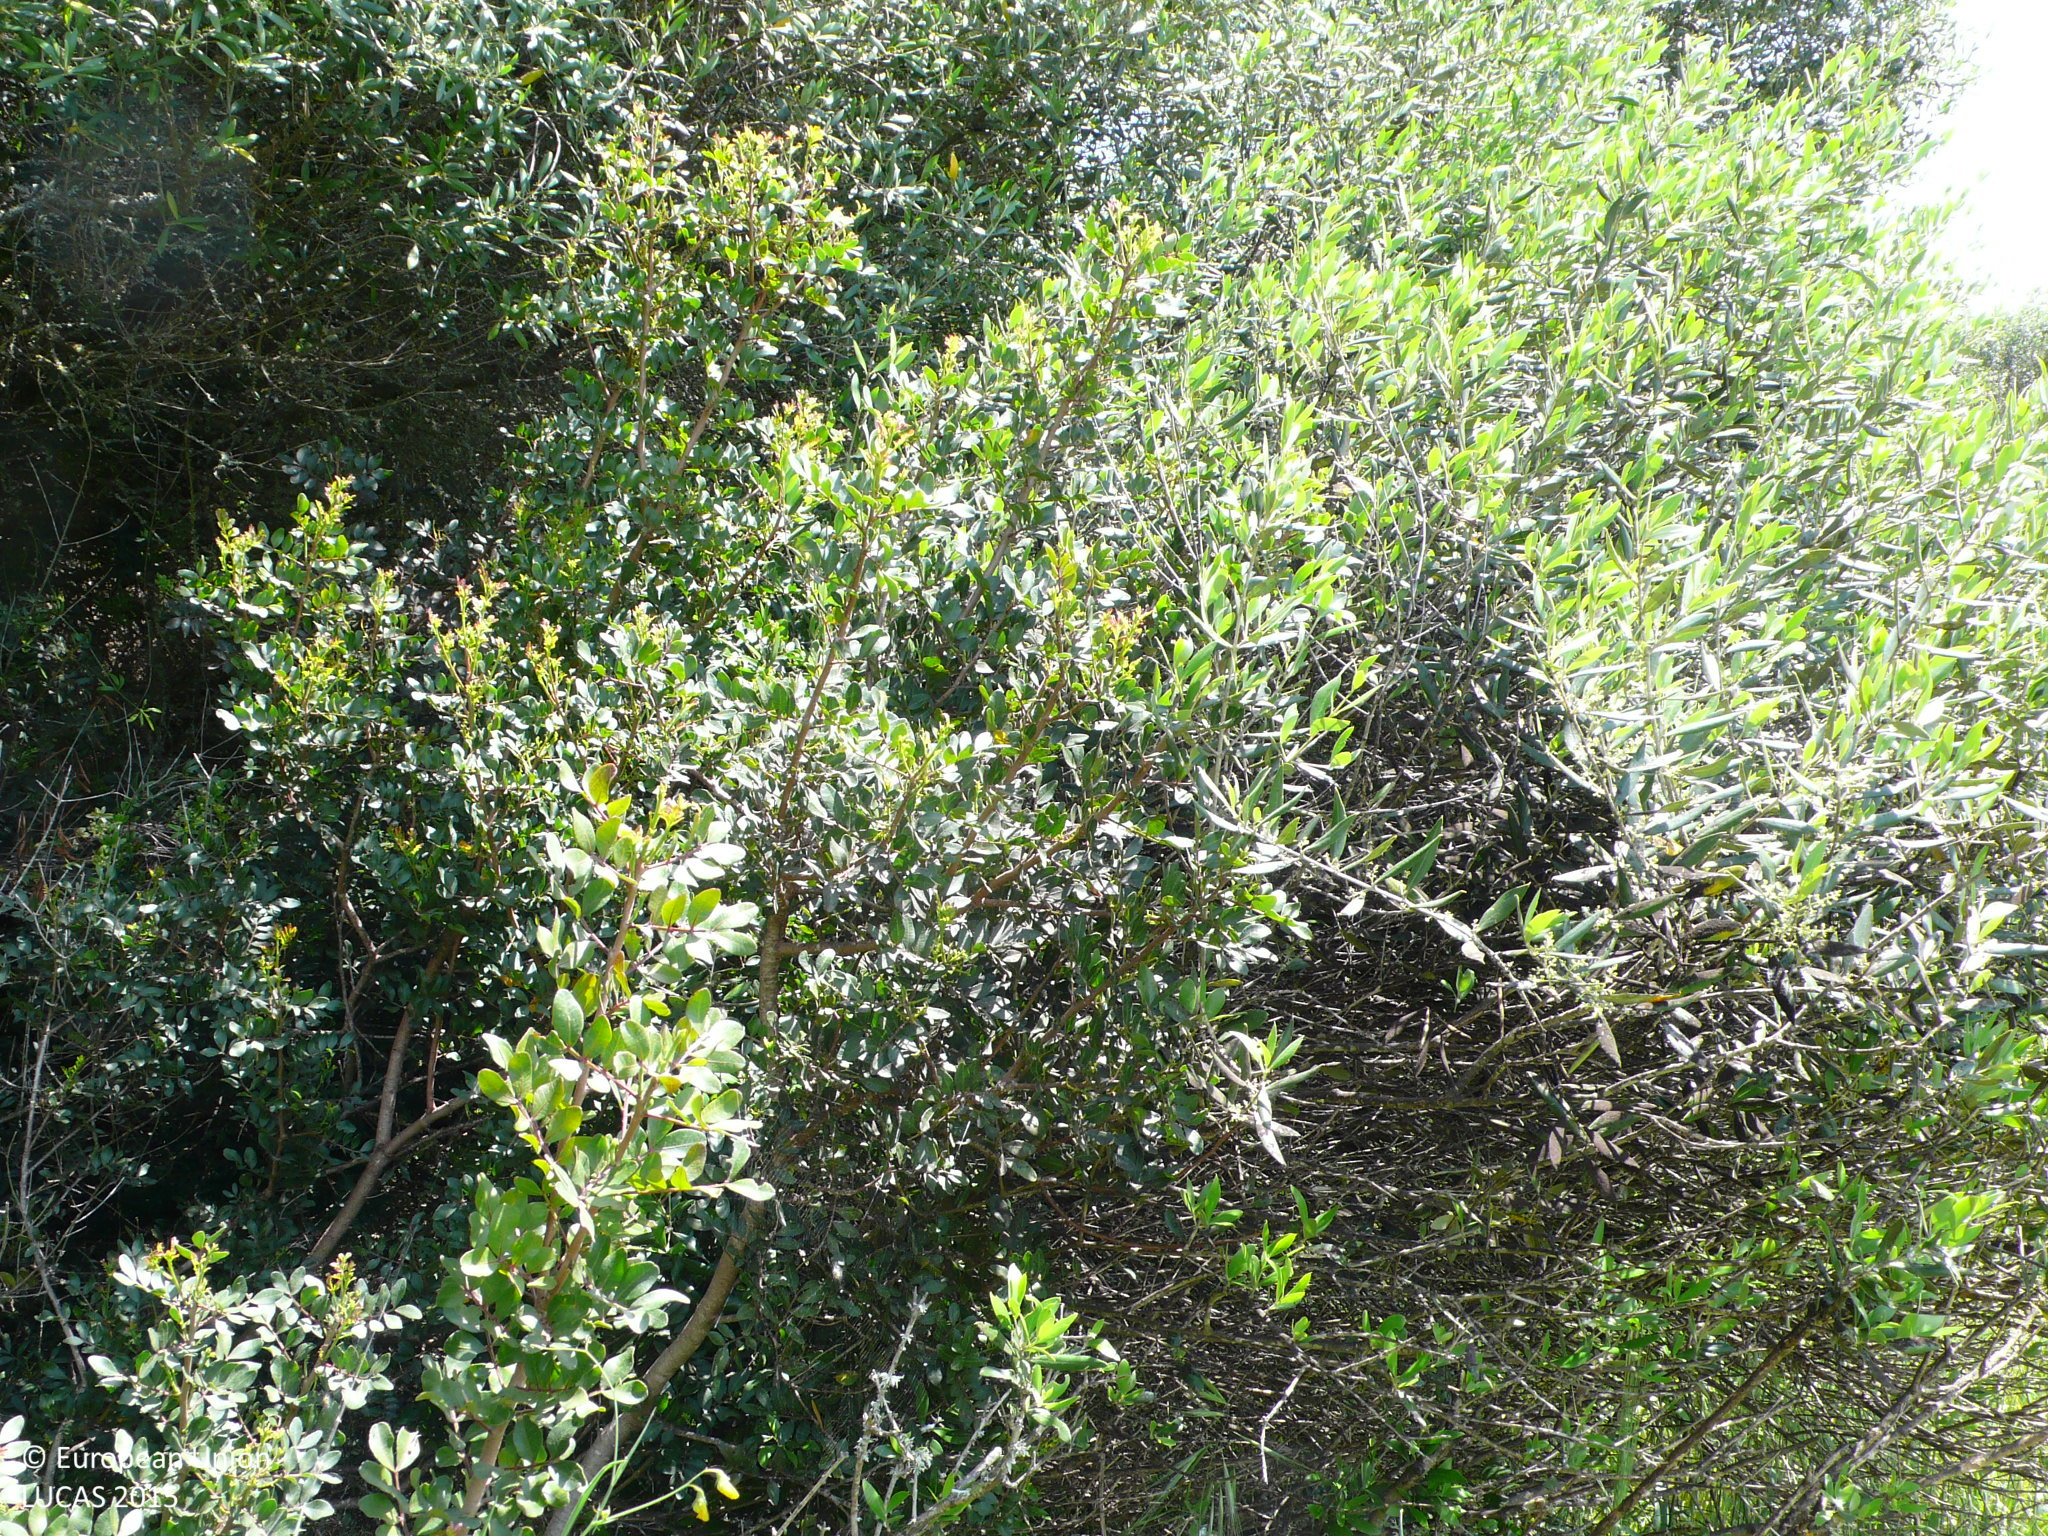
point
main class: Woodland
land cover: Broadleaved woodland
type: broadleaved evergreen forest
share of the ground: 50 - 75 %
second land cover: Grassland without tree/shrub cover
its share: 50 - 75 %
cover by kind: broadleaved forest trees 55 %, herbaceous plants 35 %, shrubs 10 %
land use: Forestry
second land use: Agriculture (excluding fallow land and kitchen gardens)
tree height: > 5 m
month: May
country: ES
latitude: 39.9232
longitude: 4.0476
